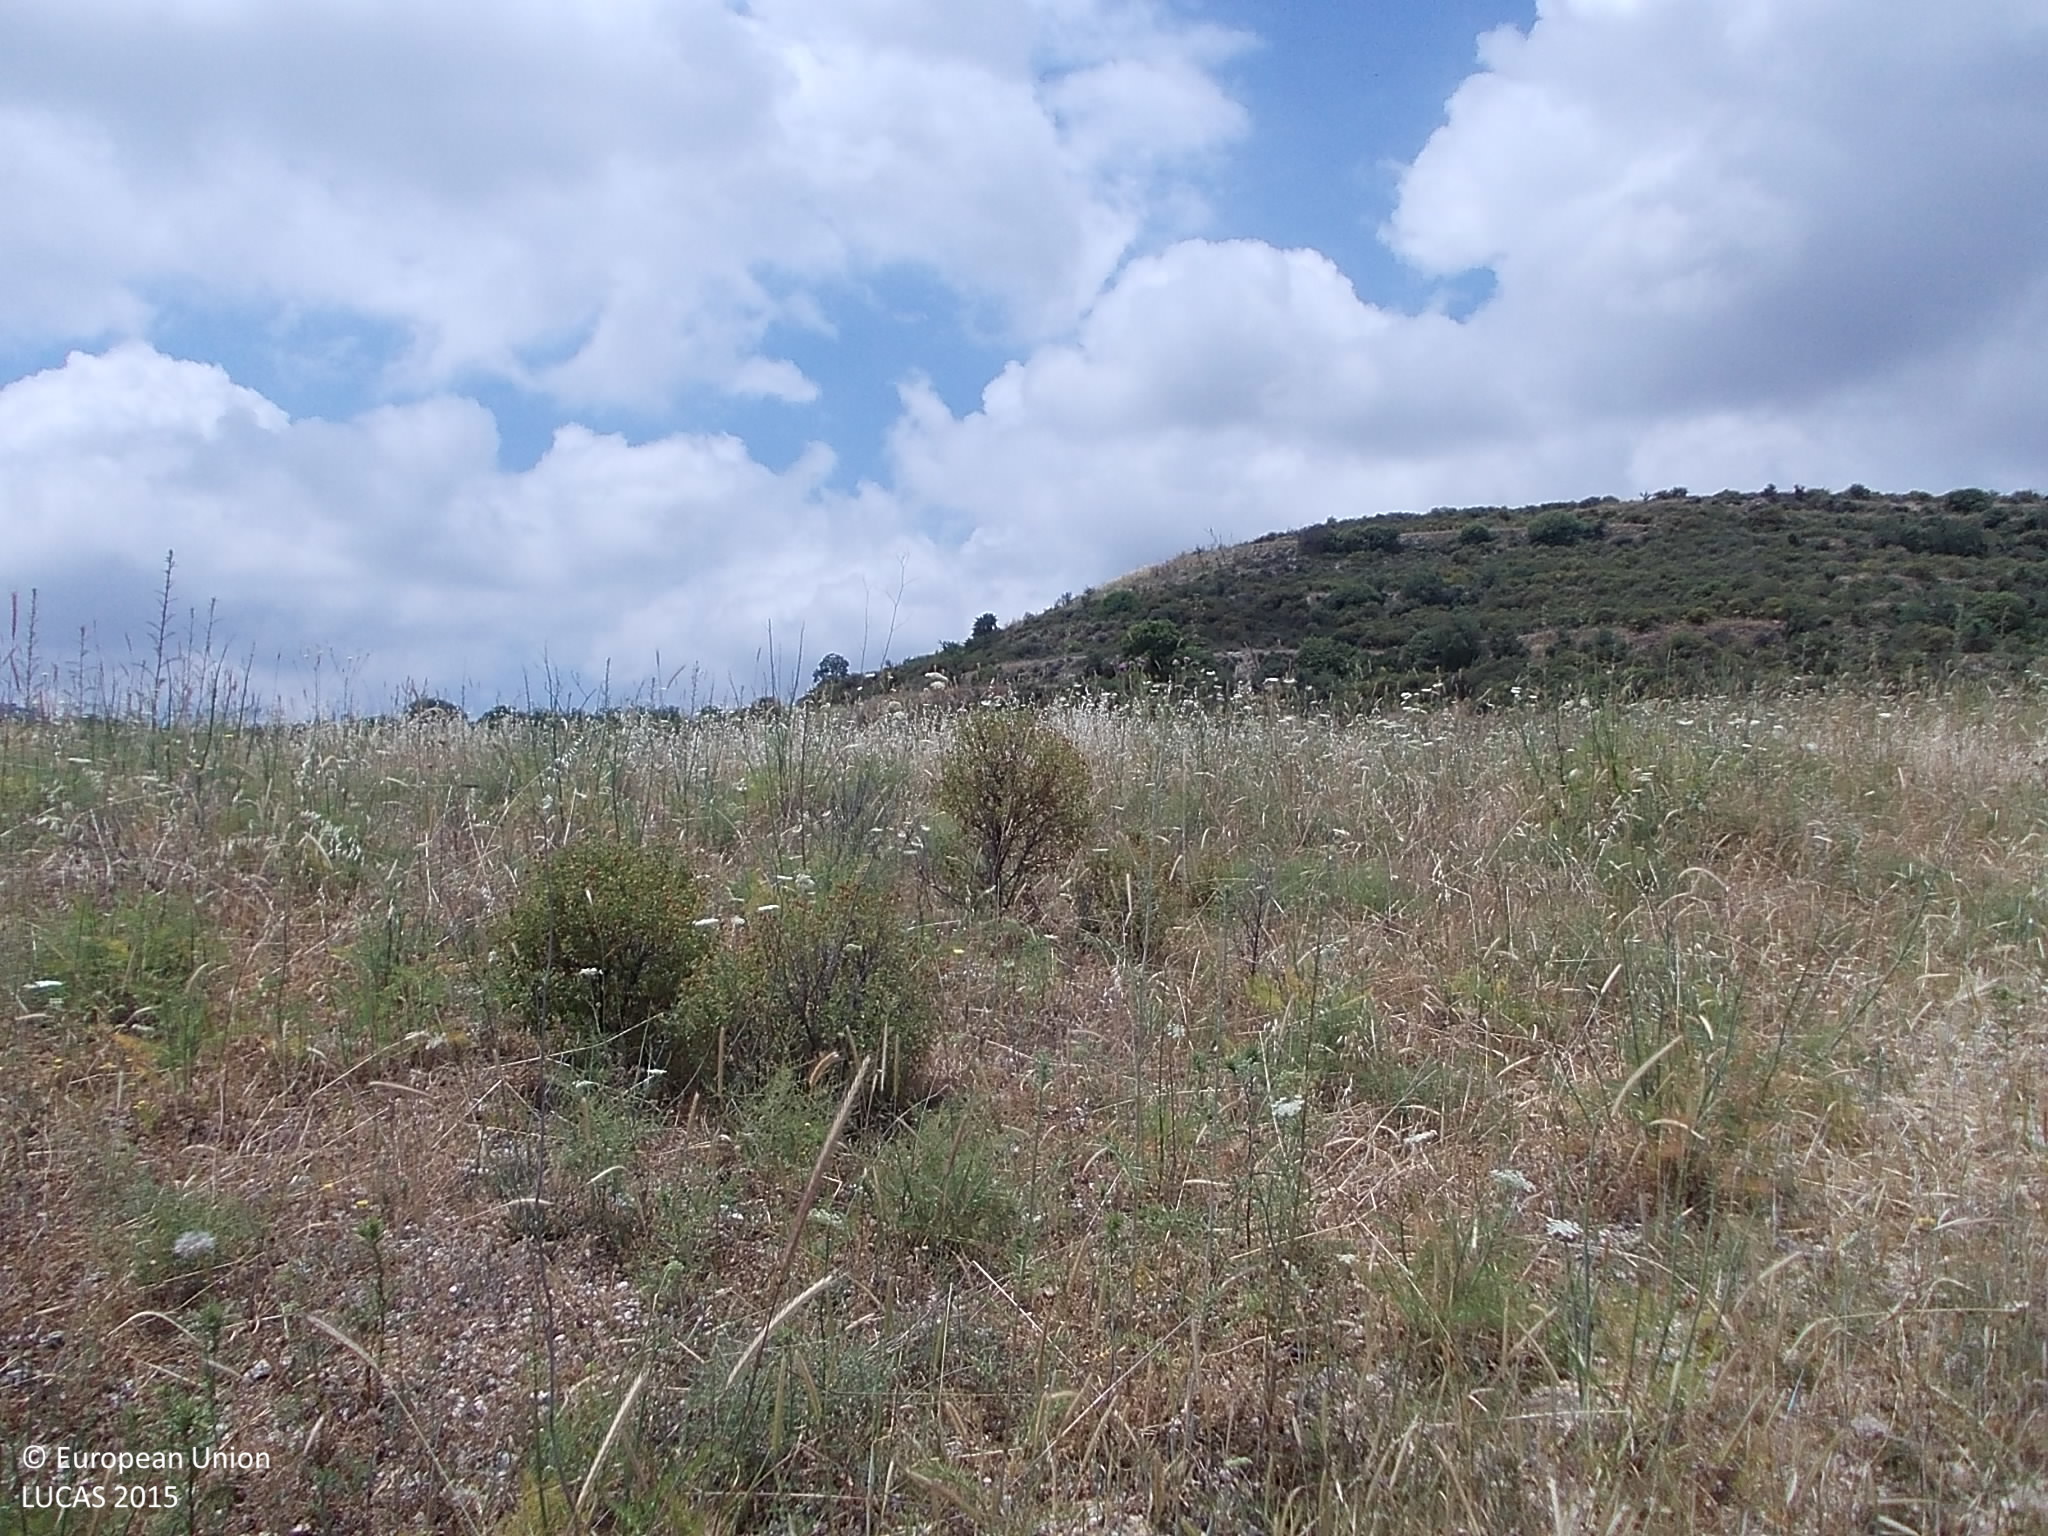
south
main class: Grassland
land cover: Spontaneously vegetated surfaces
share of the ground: > 75 %
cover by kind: herbaceous plants 90 %, shrubs 5 %, unconsolidated bare surface 5 %
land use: Fallow land
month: May
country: CY
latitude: 34.7852
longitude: 32.8138
